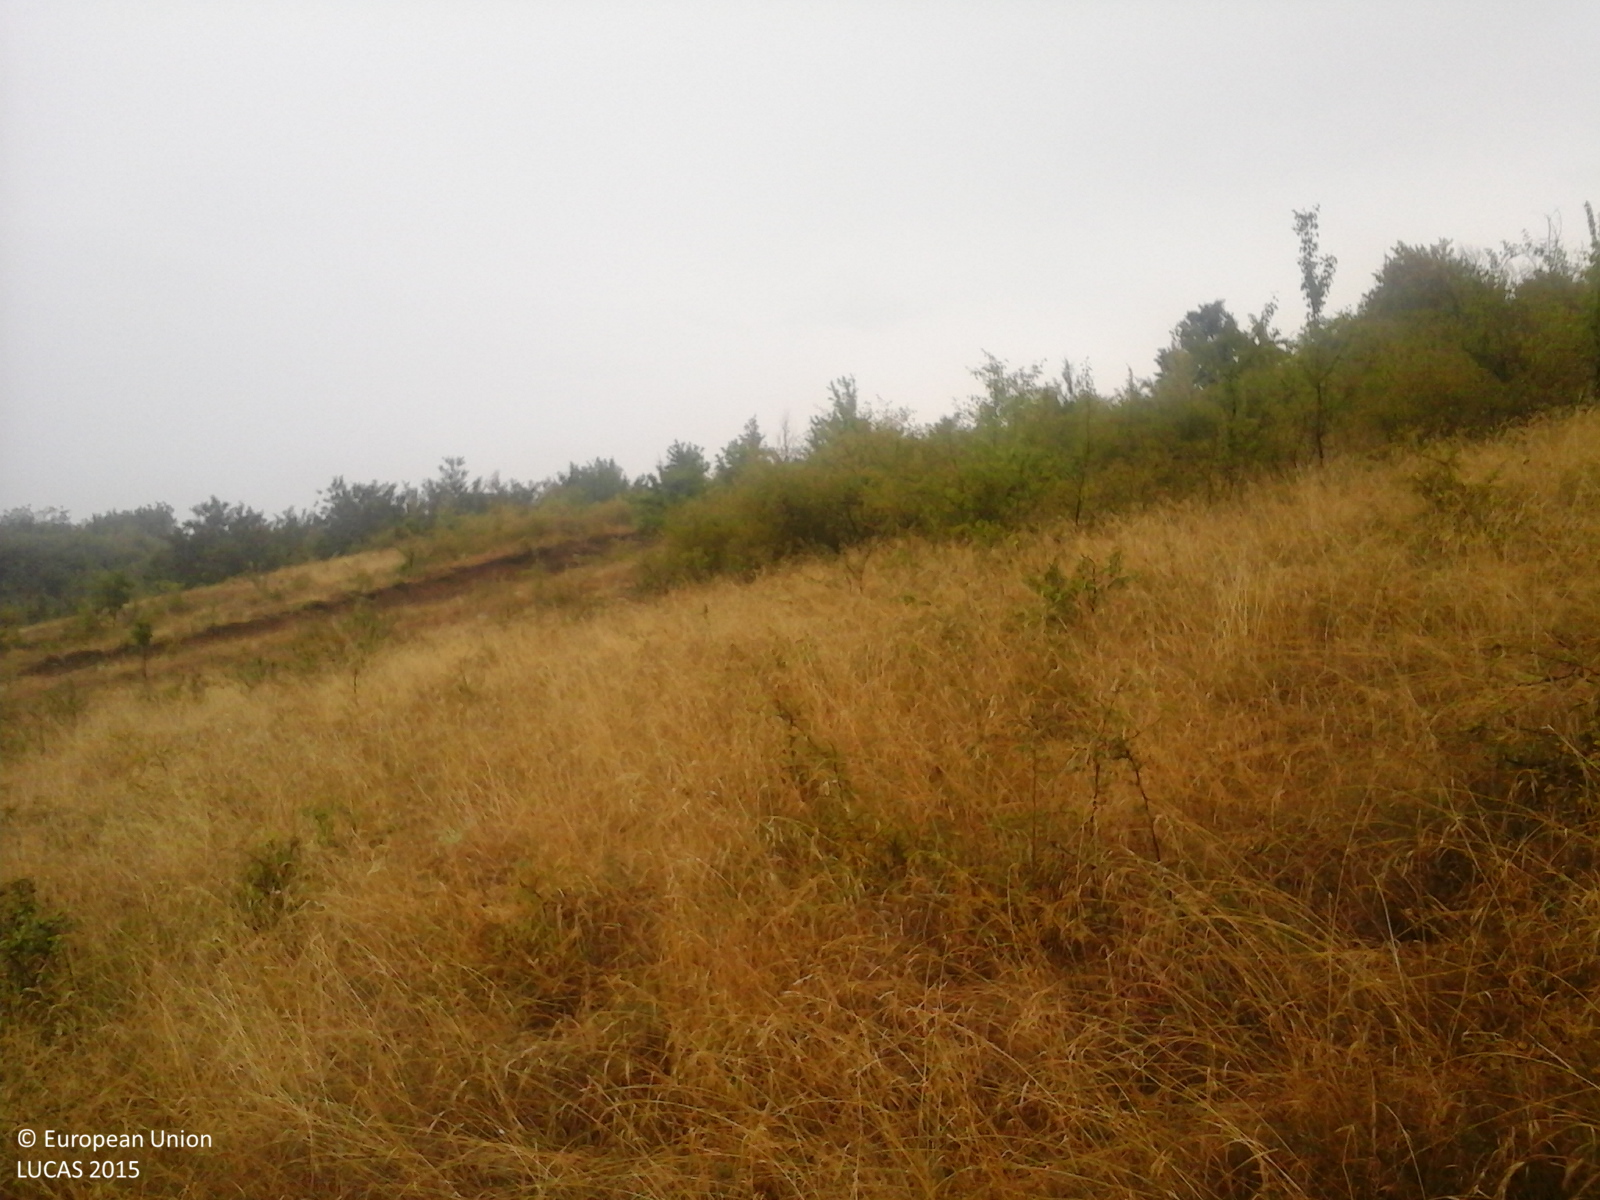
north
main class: Woodland
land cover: Broadleaved woodland
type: acidophilous oak and oak-birch forest
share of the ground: > 75 %
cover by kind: broadleaved forest trees 100 %
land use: Forestry
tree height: > 5 m
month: August
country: RO
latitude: 44.6882
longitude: 22.7748
